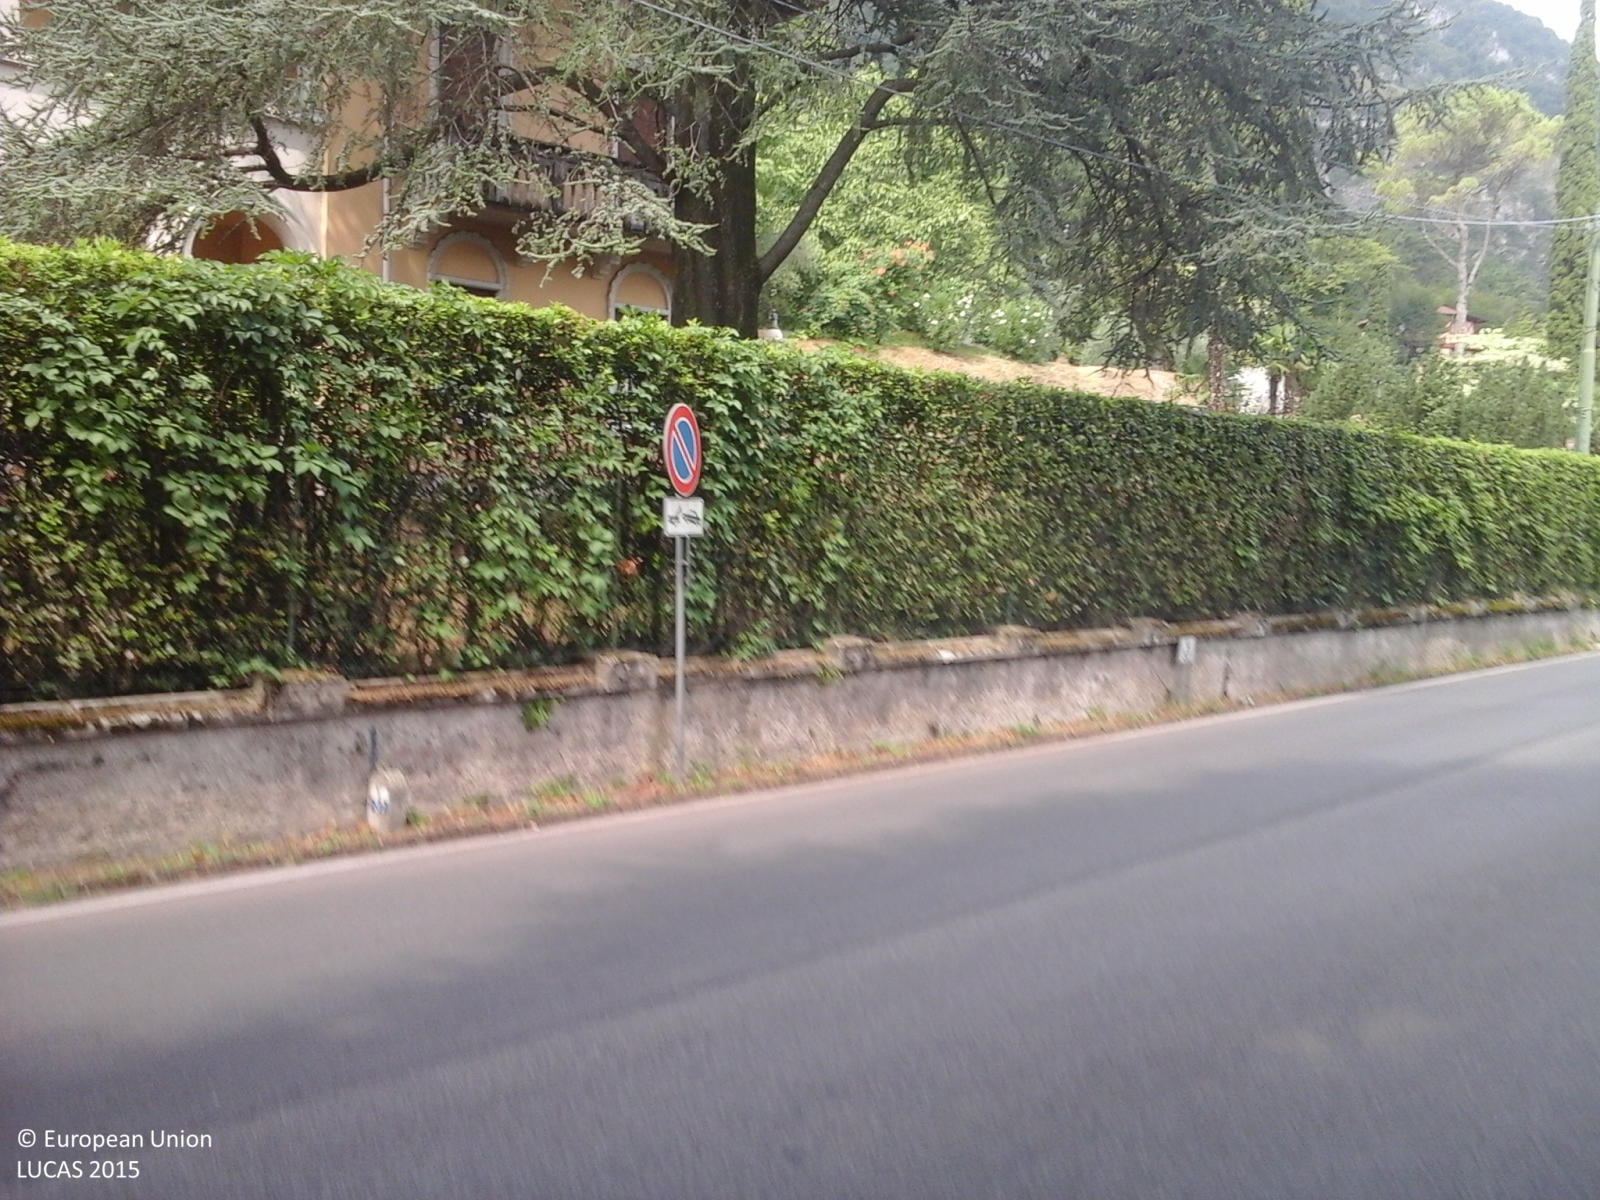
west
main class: Woodland
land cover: Other coniferous woodland
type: alpine coniferous forest
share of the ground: > 75 %
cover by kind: coniferous forest trees 100 %
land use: Residential
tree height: > 5 m
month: July
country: IT
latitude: 45.9165
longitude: 9.2920
